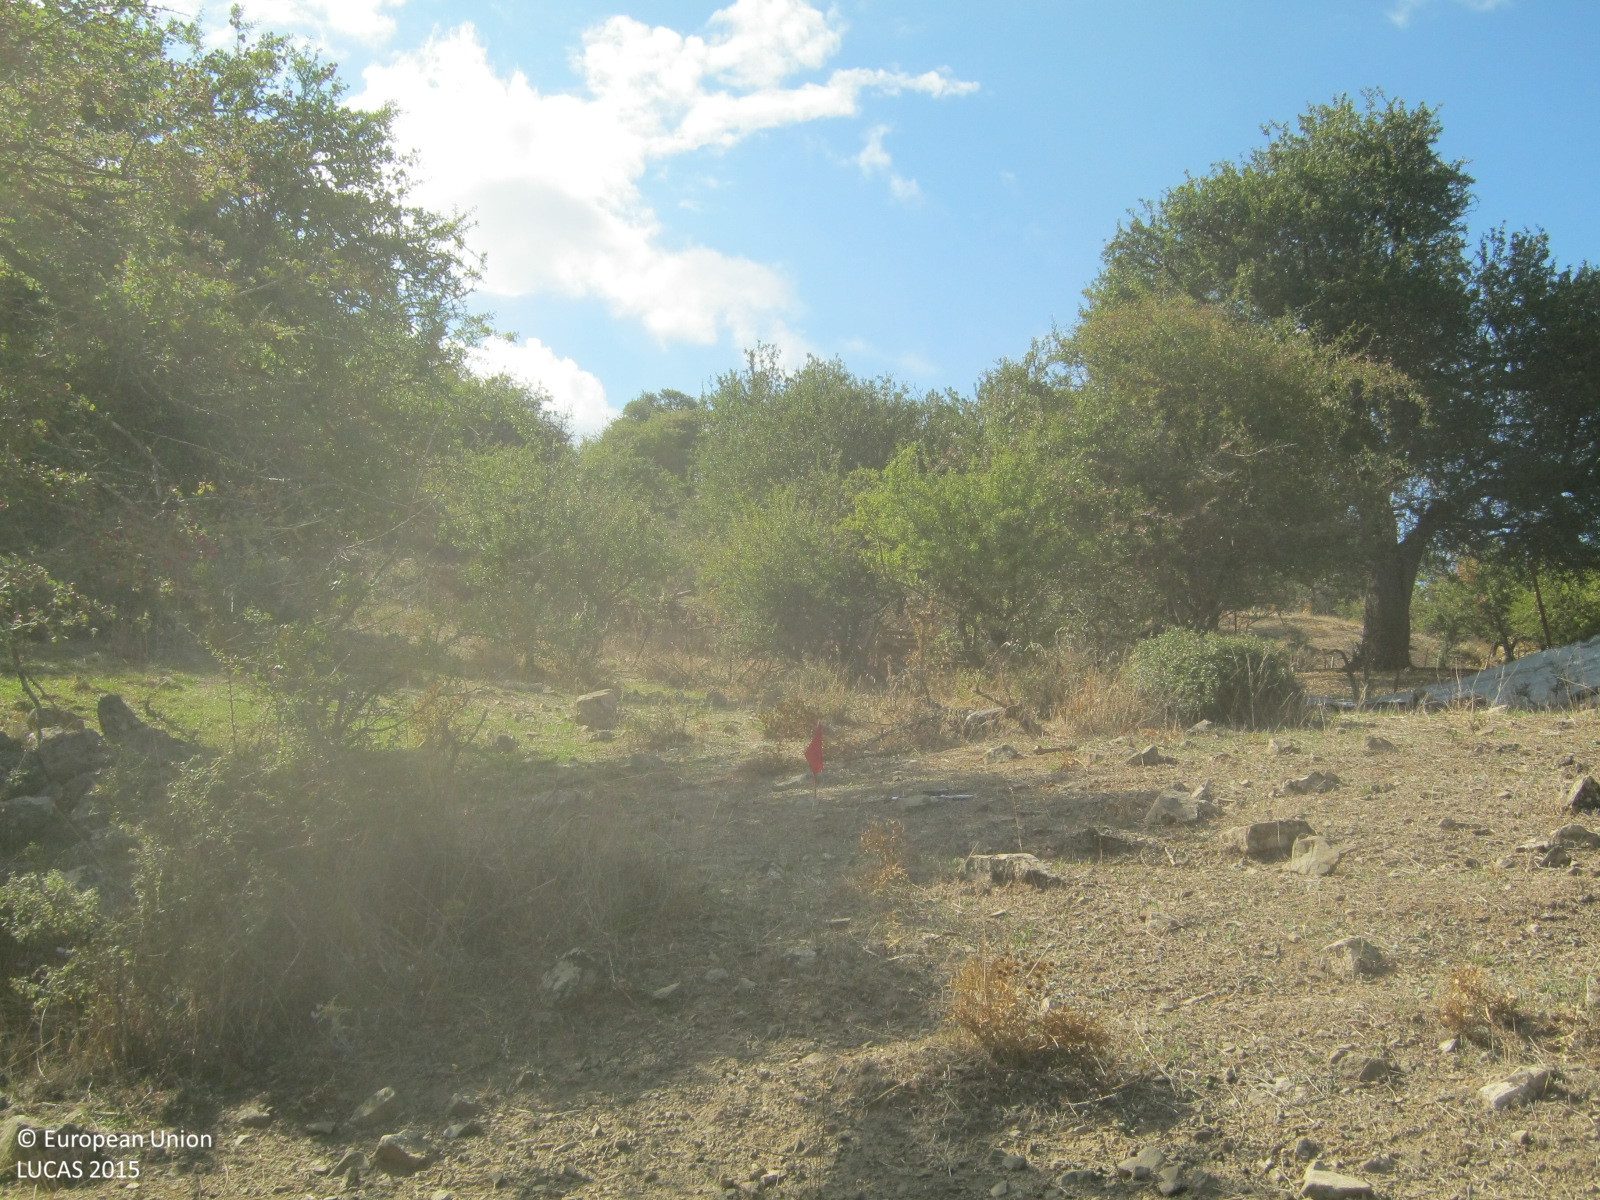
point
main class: Shrubland
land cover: Shrubland with sparse tree cover
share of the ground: 25 - 50 %
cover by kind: herbaceous plants 50 %, shrubs 25 %, unconsolidated bare surface 20 %, broadleaved forest trees 5 %
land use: Agriculture (excluding fallow land and kitchen gardens)
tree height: < 5 m
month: September
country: GR
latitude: 38.1383
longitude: 22.1426
